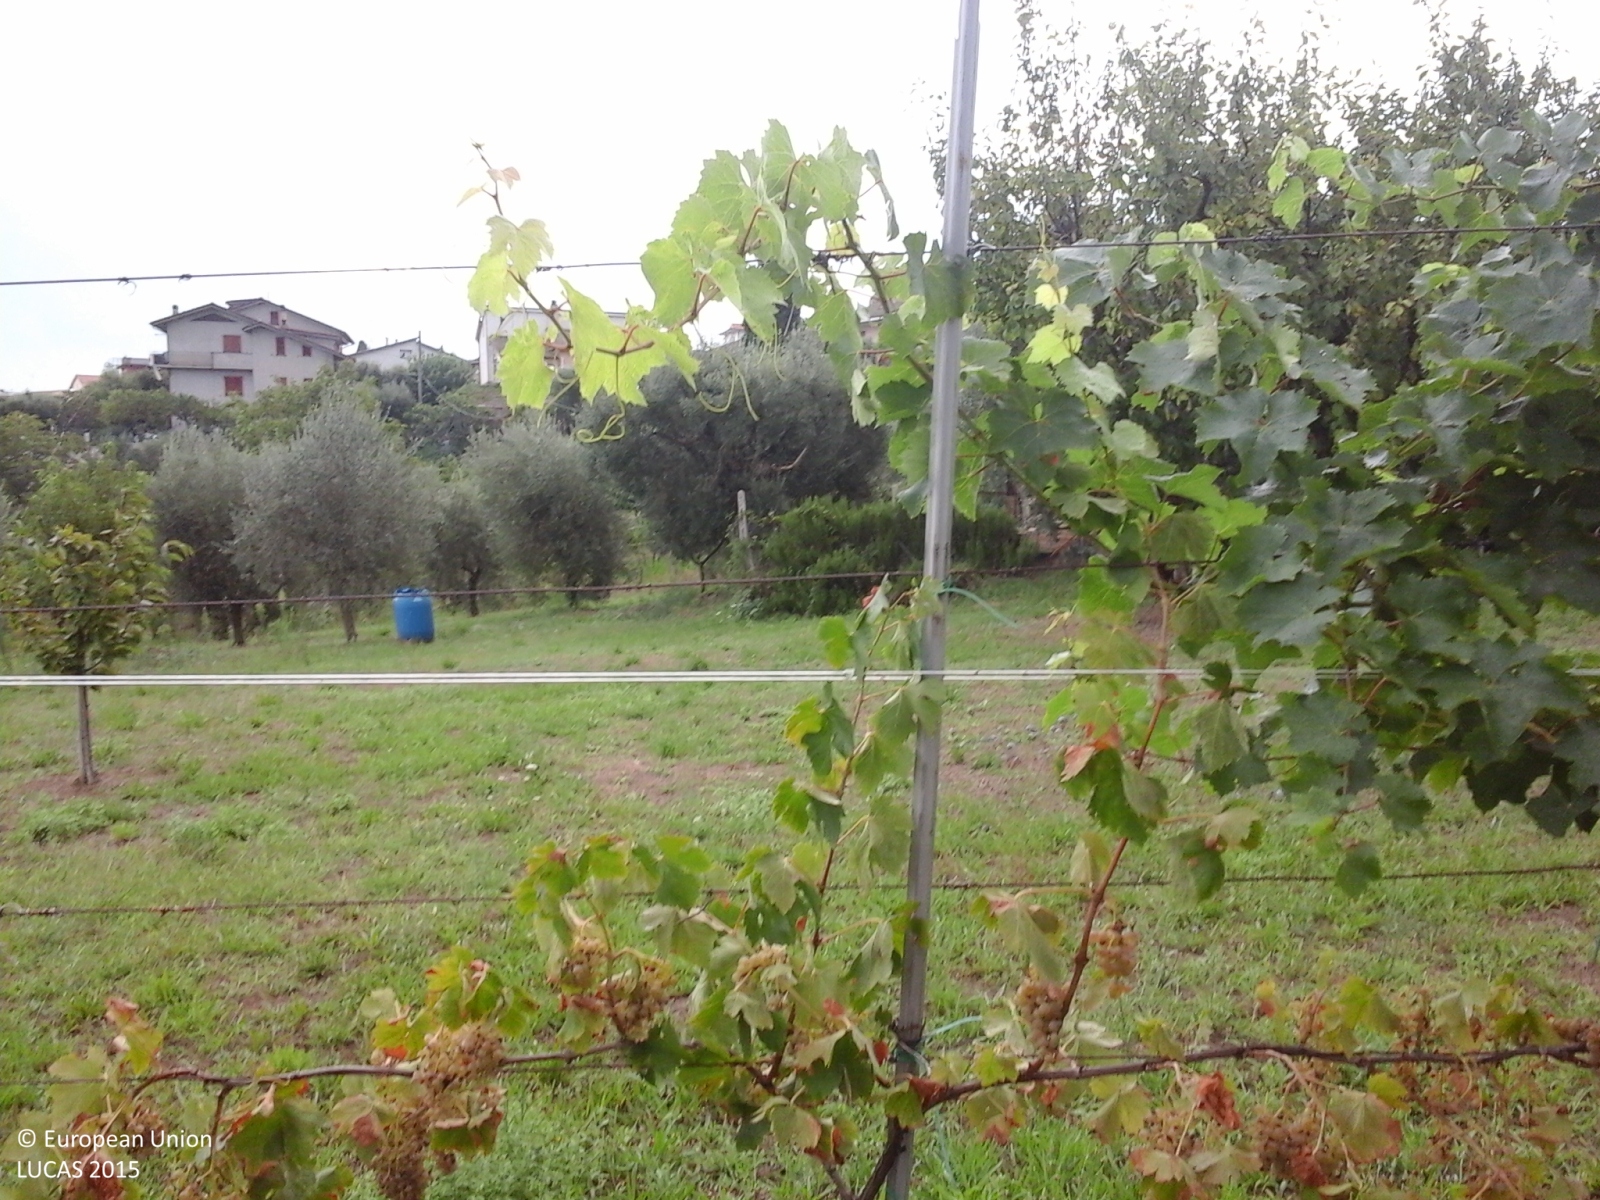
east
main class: Cropland
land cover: Vineyards
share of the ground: 50 - 75 %
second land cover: Spontaneously vegetated surfaces
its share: > 75 %
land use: Agriculture (excluding fallow land and kitchen gardens)
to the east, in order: Vineyards; Spontaneously vegetated surfaces; Olive groves; Vineyards; Olive groves; Artificial constructions in urban areas
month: August
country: IT
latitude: 43.4536
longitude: 13.1680
